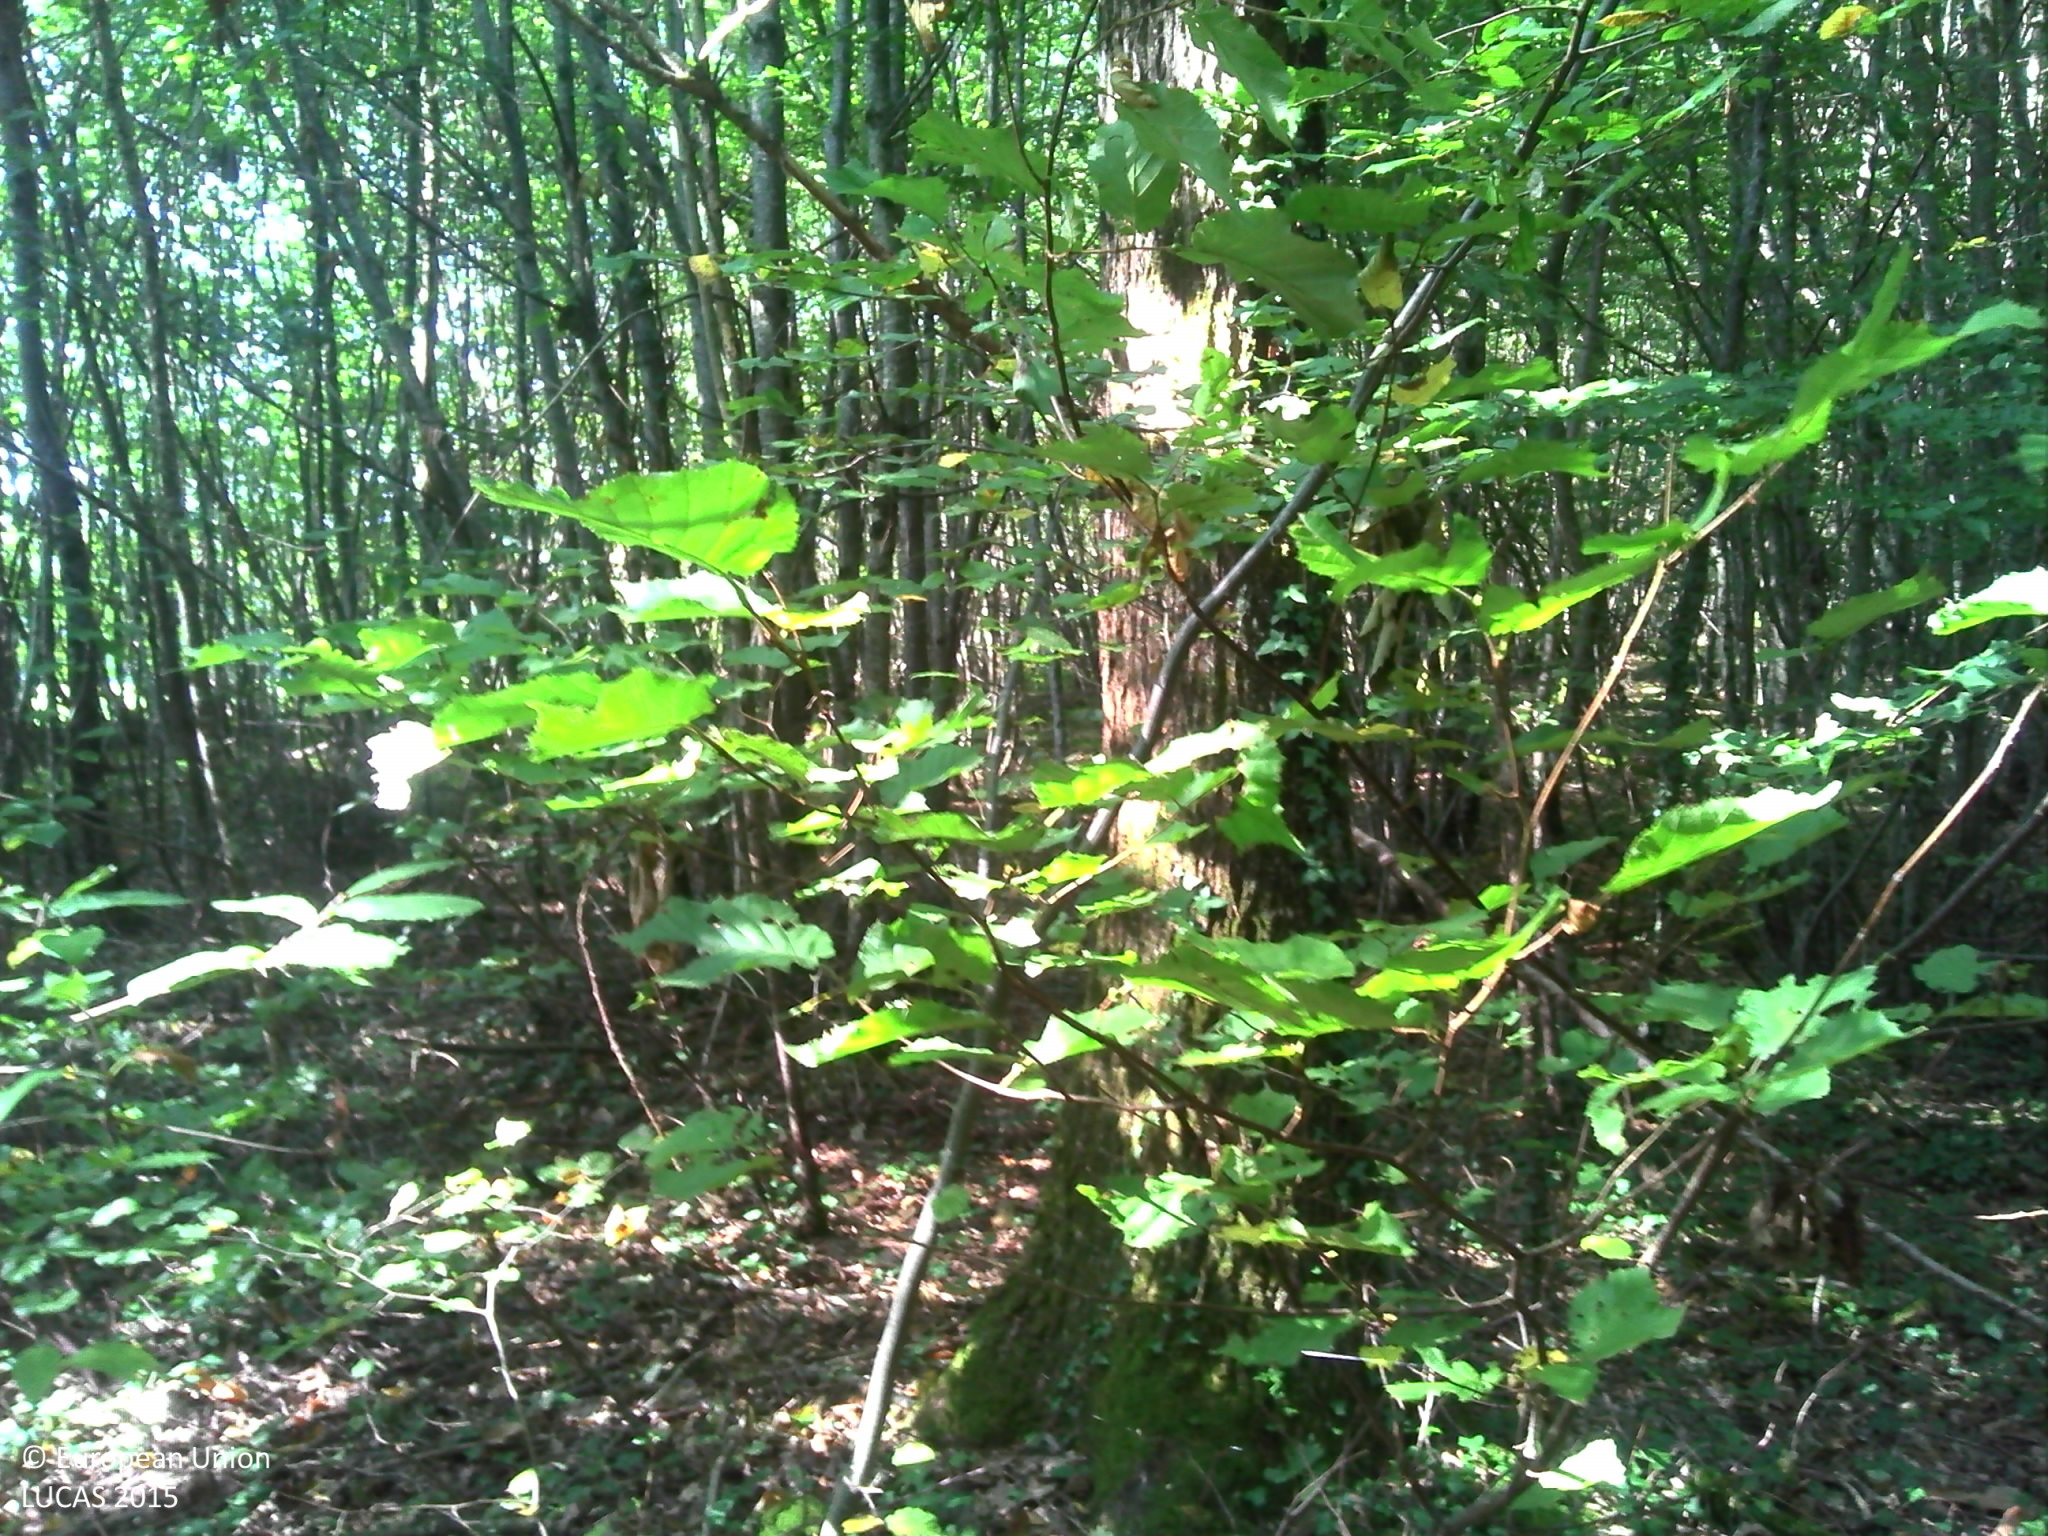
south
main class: Woodland
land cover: Broadleaved woodland
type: mesophytic deciduous forest
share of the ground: > 75 %
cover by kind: broadleaved forest trees 95 %, unconsolidated bare surface 5 %
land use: Forestry
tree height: > 5 m
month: September
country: FR
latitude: 47.0400
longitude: 1.4459
